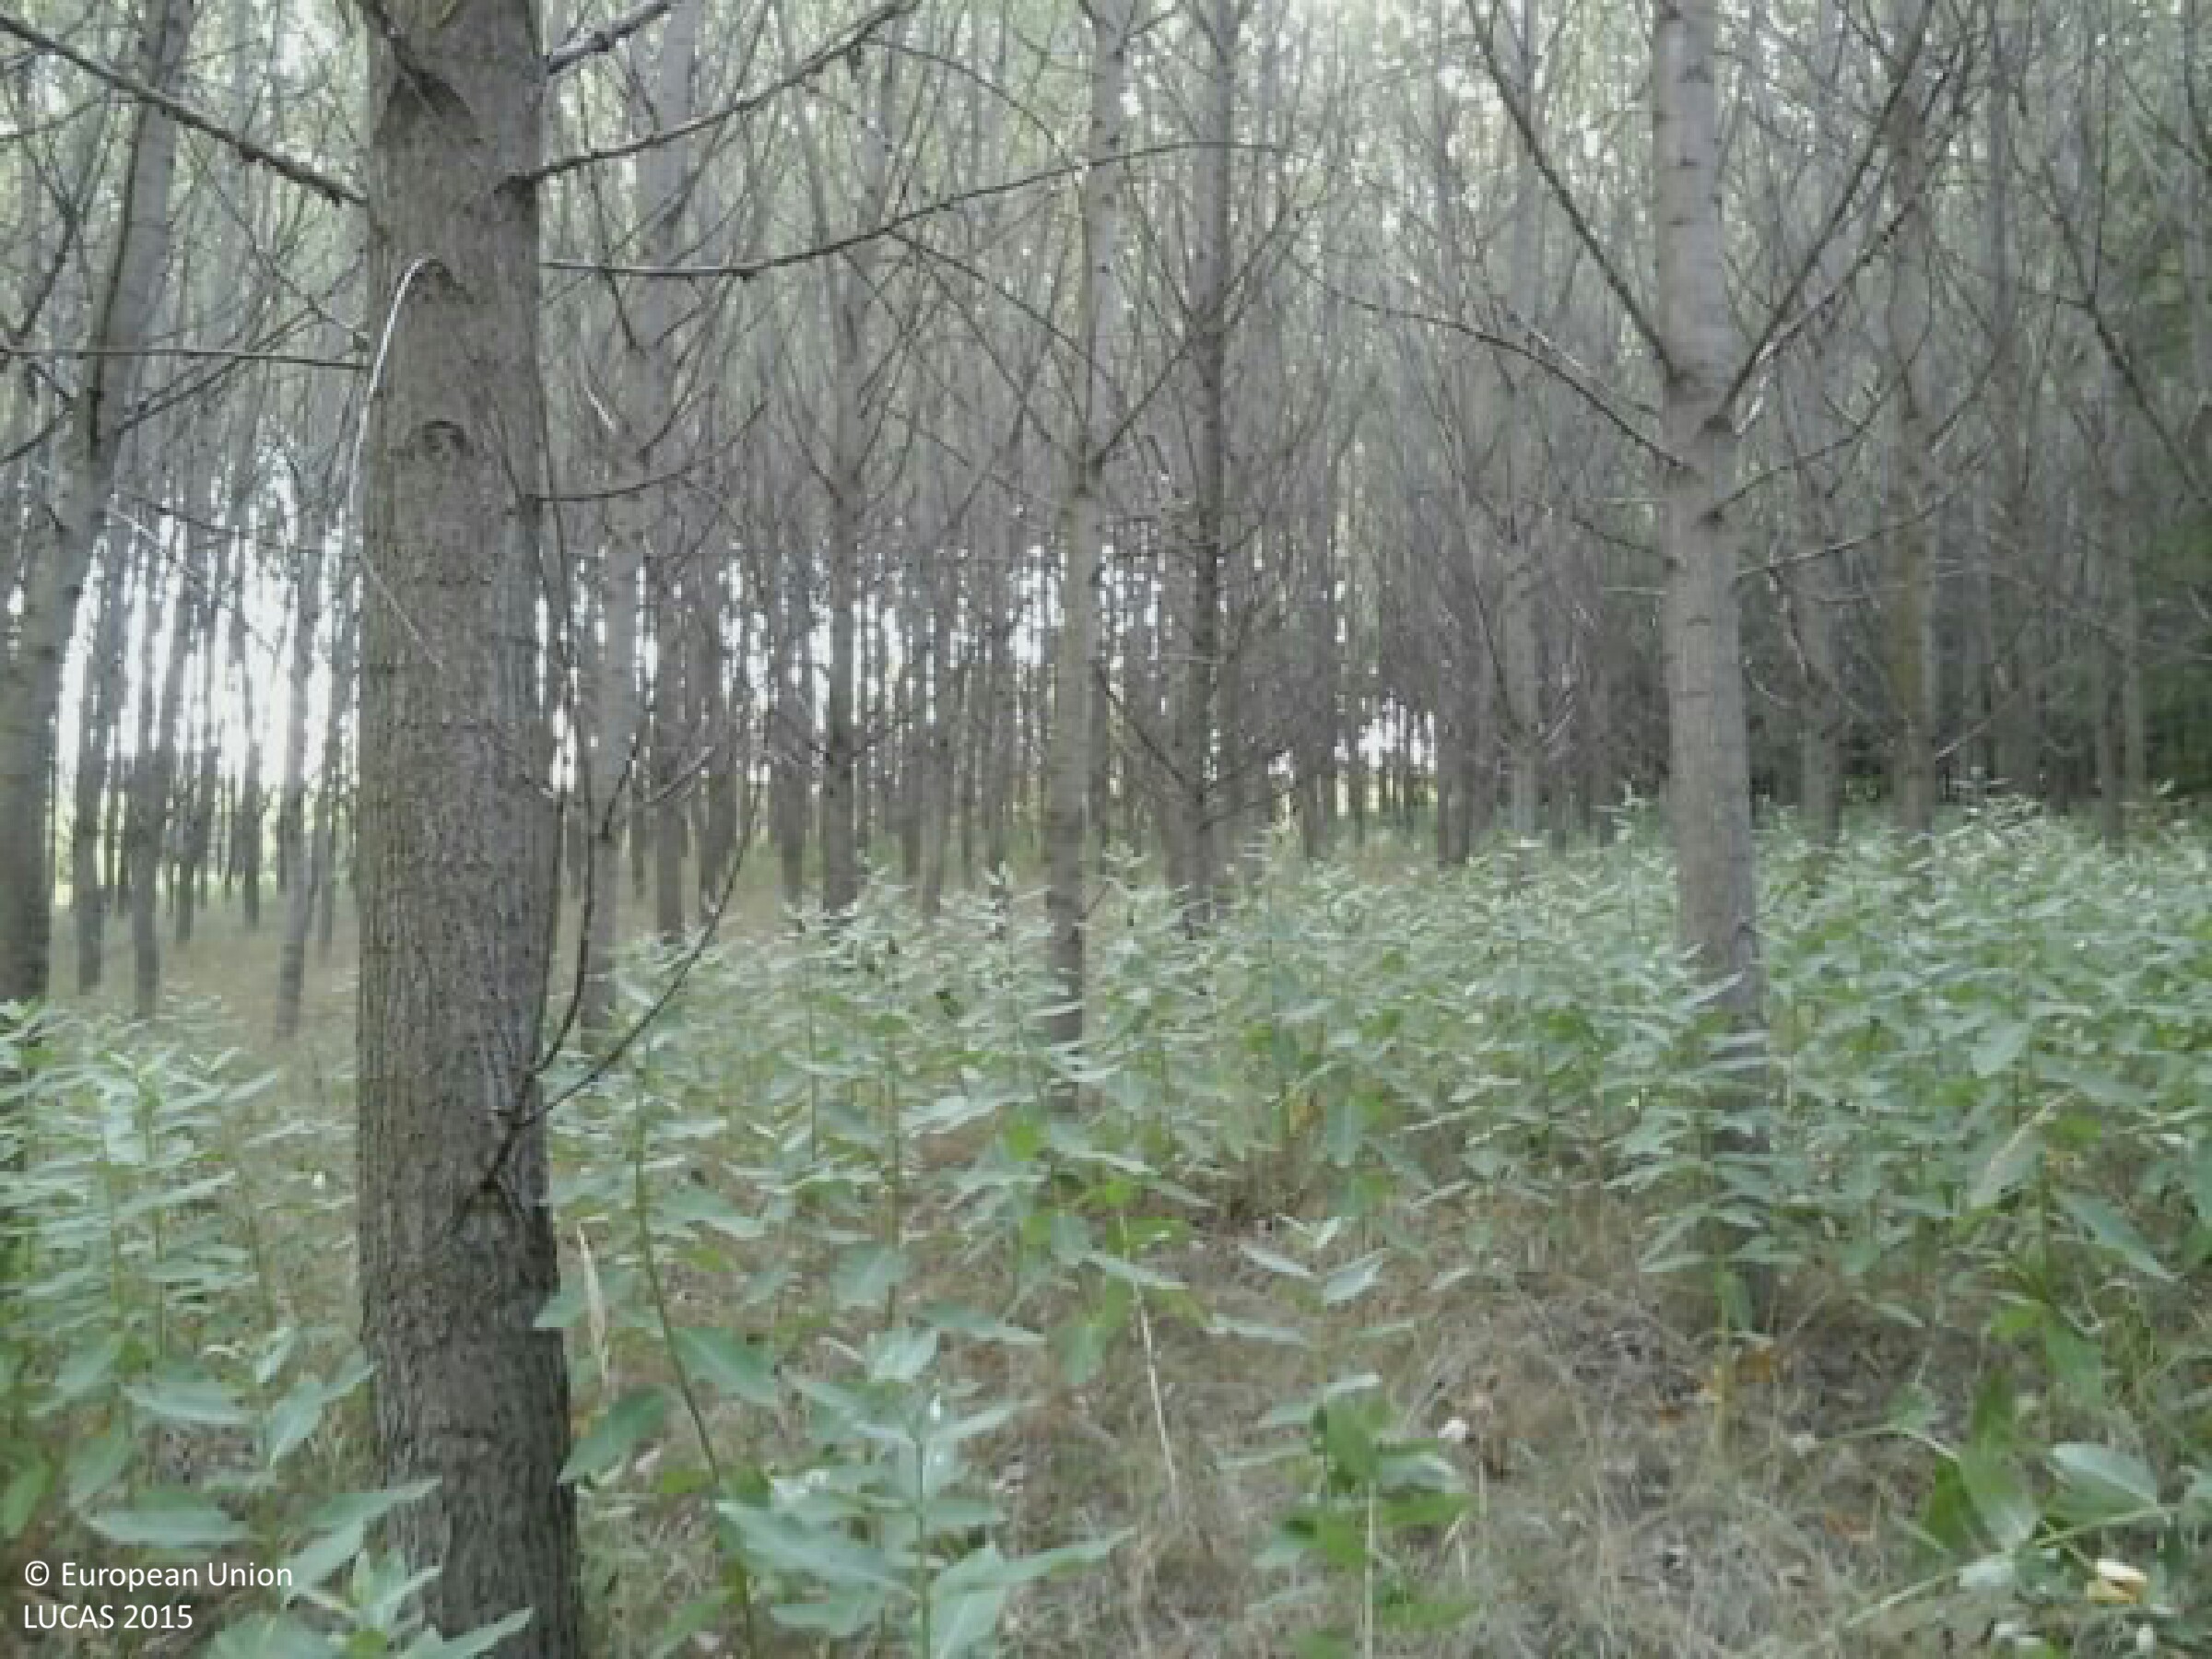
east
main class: Woodland
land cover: Broadleaved woodland
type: mesophytic deciduous forest
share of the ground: > 75 %
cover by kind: broadleaved forest trees 85 %, herbaceous plants 15 %
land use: Forestry
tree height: > 5 m
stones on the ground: < 10 %
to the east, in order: Broadleaved woodland; Tracks; Grass margins; Broadleaved woodland; Grassland without tree/shrub cover
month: August
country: HU
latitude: 47.0140
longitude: 19.7163
